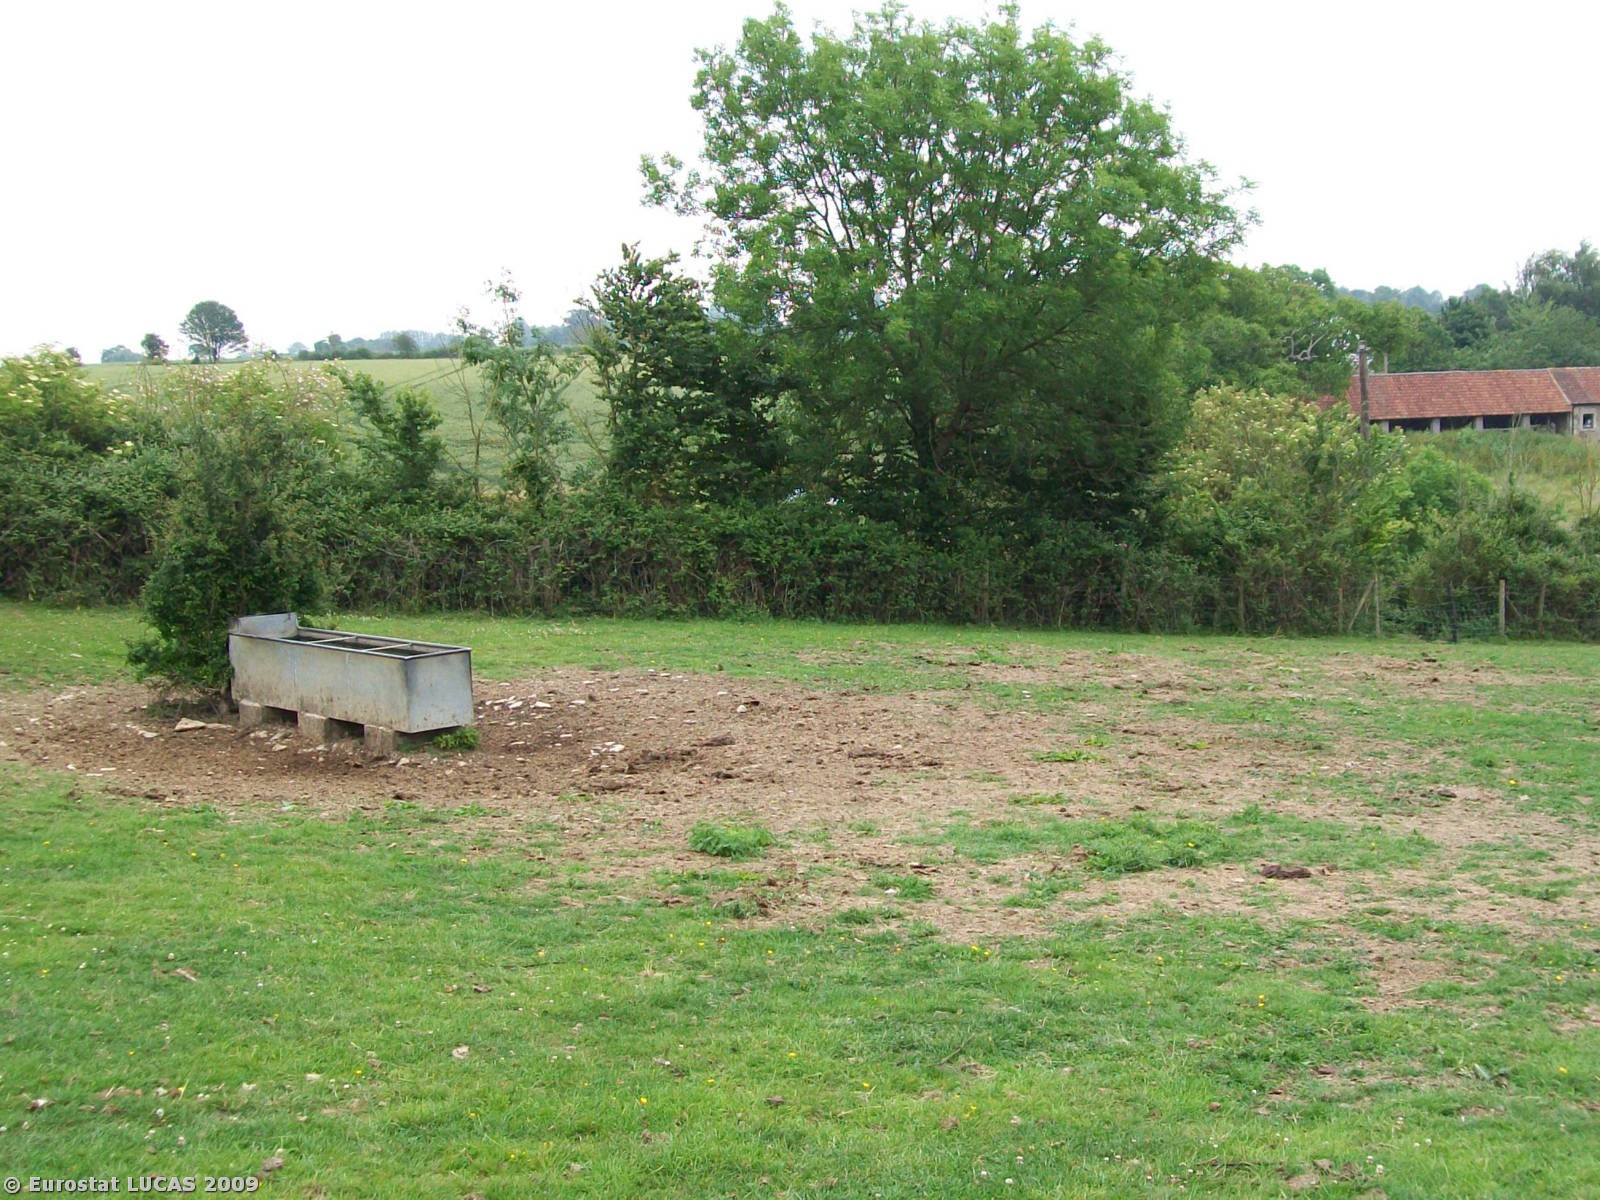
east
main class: Grassland
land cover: Grassland without tree/shrub cover
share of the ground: > 75 %
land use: Agriculture (excluding fallow land and kitchen gardens)
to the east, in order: Grassland without tree/shrub cover; Abandoned hedges; Tracks; Abandoned hedges; Grassland without tree/shrub cover; Abandoned hedges; Grassland without tree/shrub cover; Fences; Tracks; Grass margins; Common wheat
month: June
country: GB
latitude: 51.3192
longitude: -2.2734
